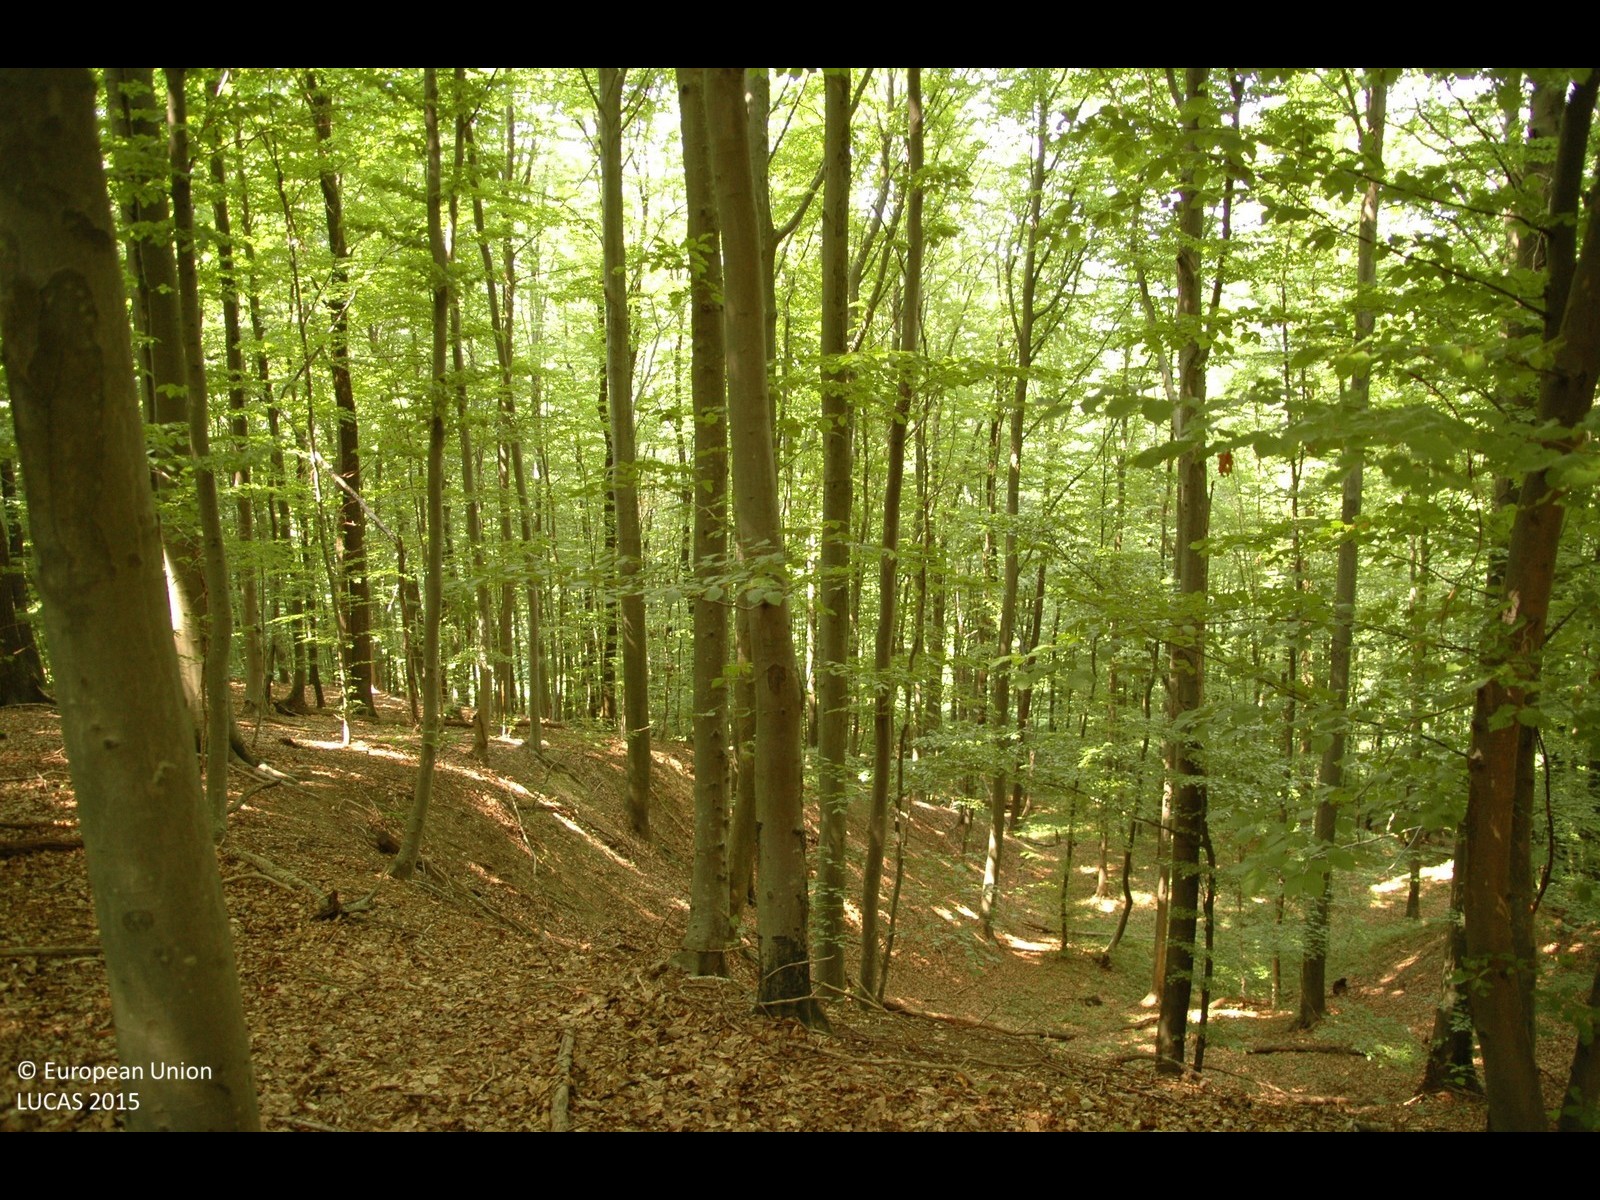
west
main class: Woodland
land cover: Broadleaved woodland
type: mesophytic deciduous forest
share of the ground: > 75 %
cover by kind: broadleaved forest trees 100 %
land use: Forestry
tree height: > 5 m
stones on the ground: < 10 %
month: July
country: HR
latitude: 46.1674
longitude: 16.5668
